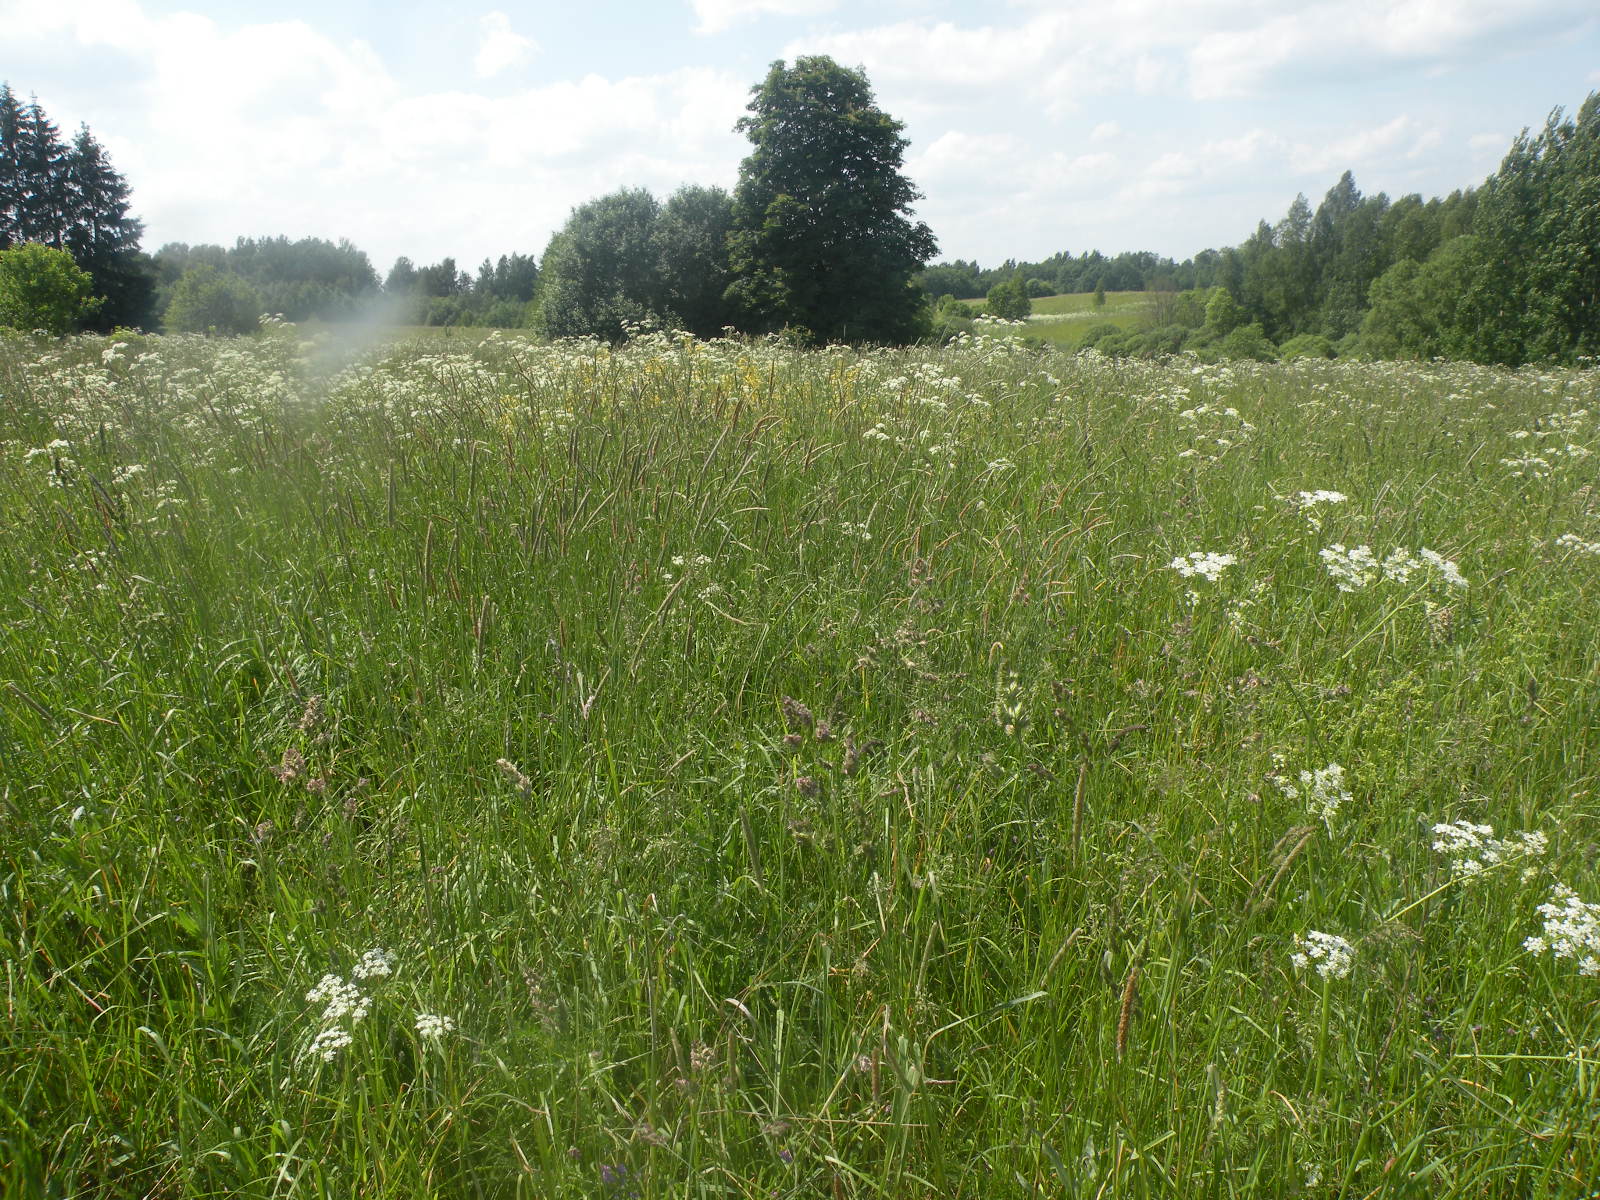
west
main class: Grassland
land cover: Spontaneously vegetated surfaces
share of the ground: > 75 %
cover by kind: herbaceous plants 100 %
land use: Semi-natural and natural areas not in use
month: June
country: LV
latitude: 56.1302
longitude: 26.8442
